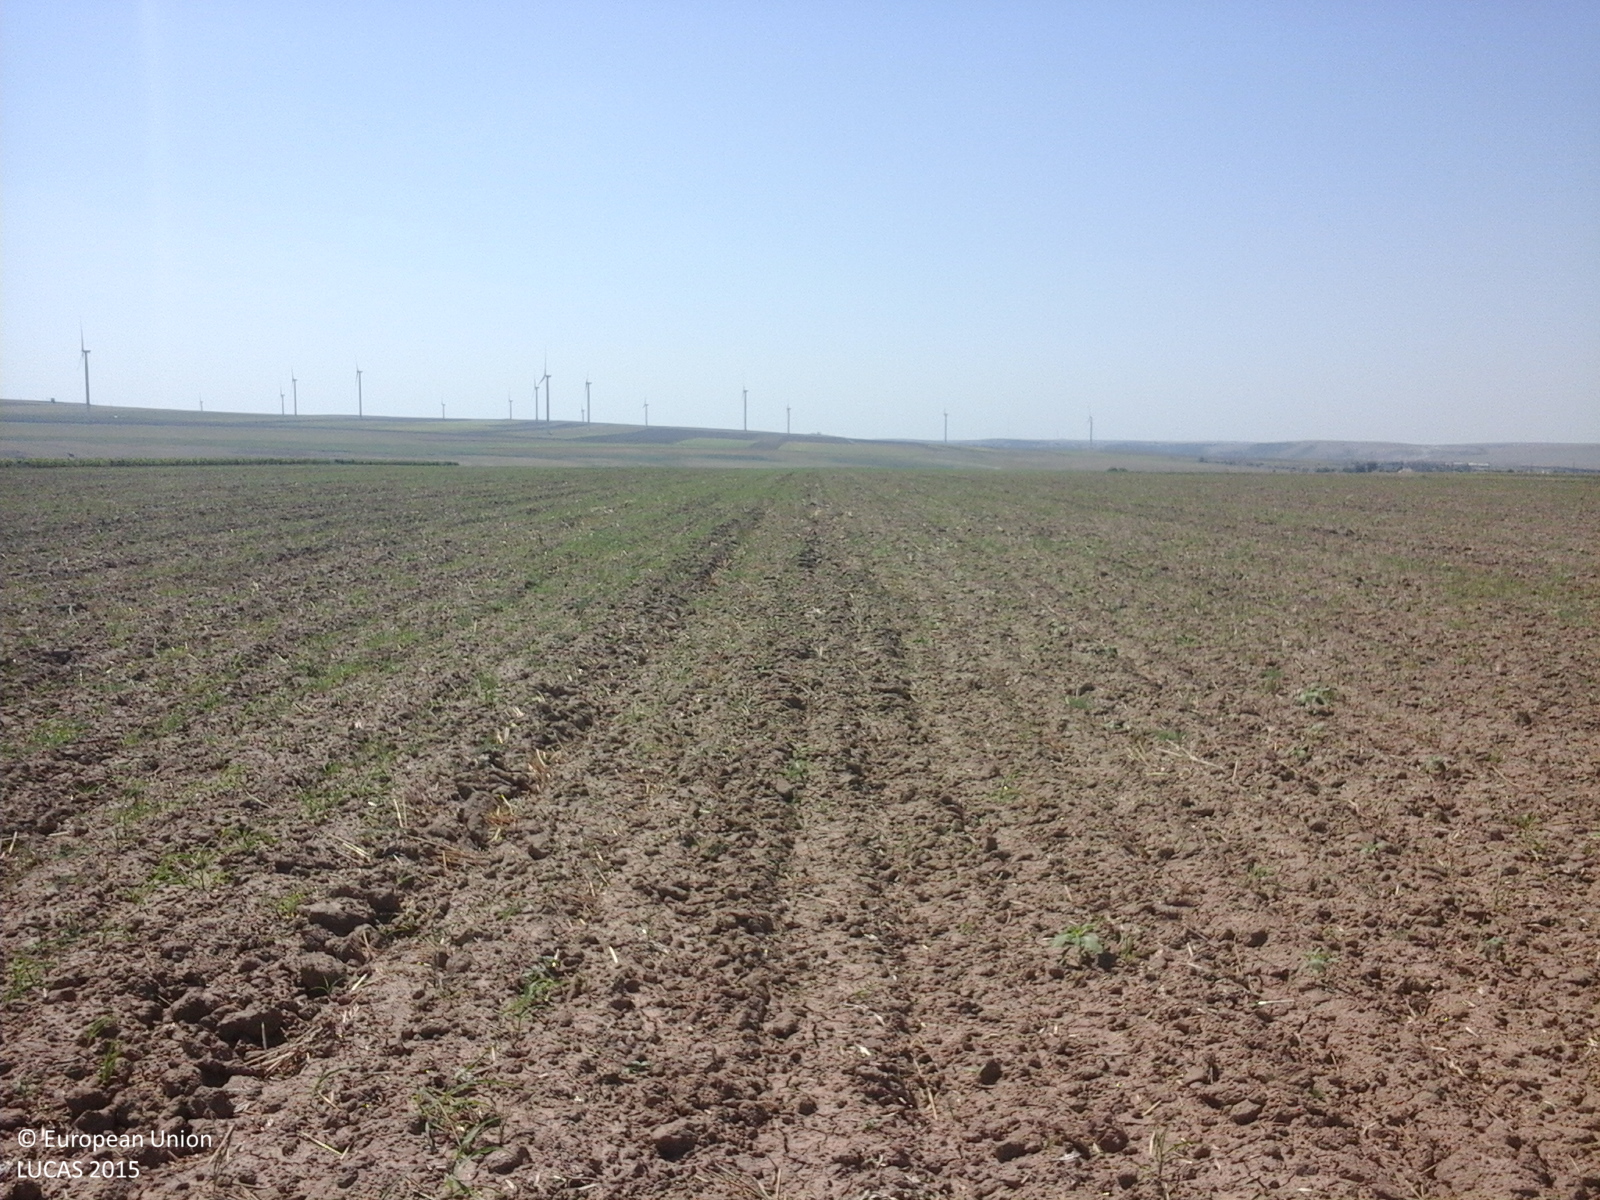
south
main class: Cropland
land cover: Durum wheat
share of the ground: < 10 %
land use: Agriculture (excluding fallow land and kitchen gardens)
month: August
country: RO
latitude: 44.5807
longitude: 28.4474
